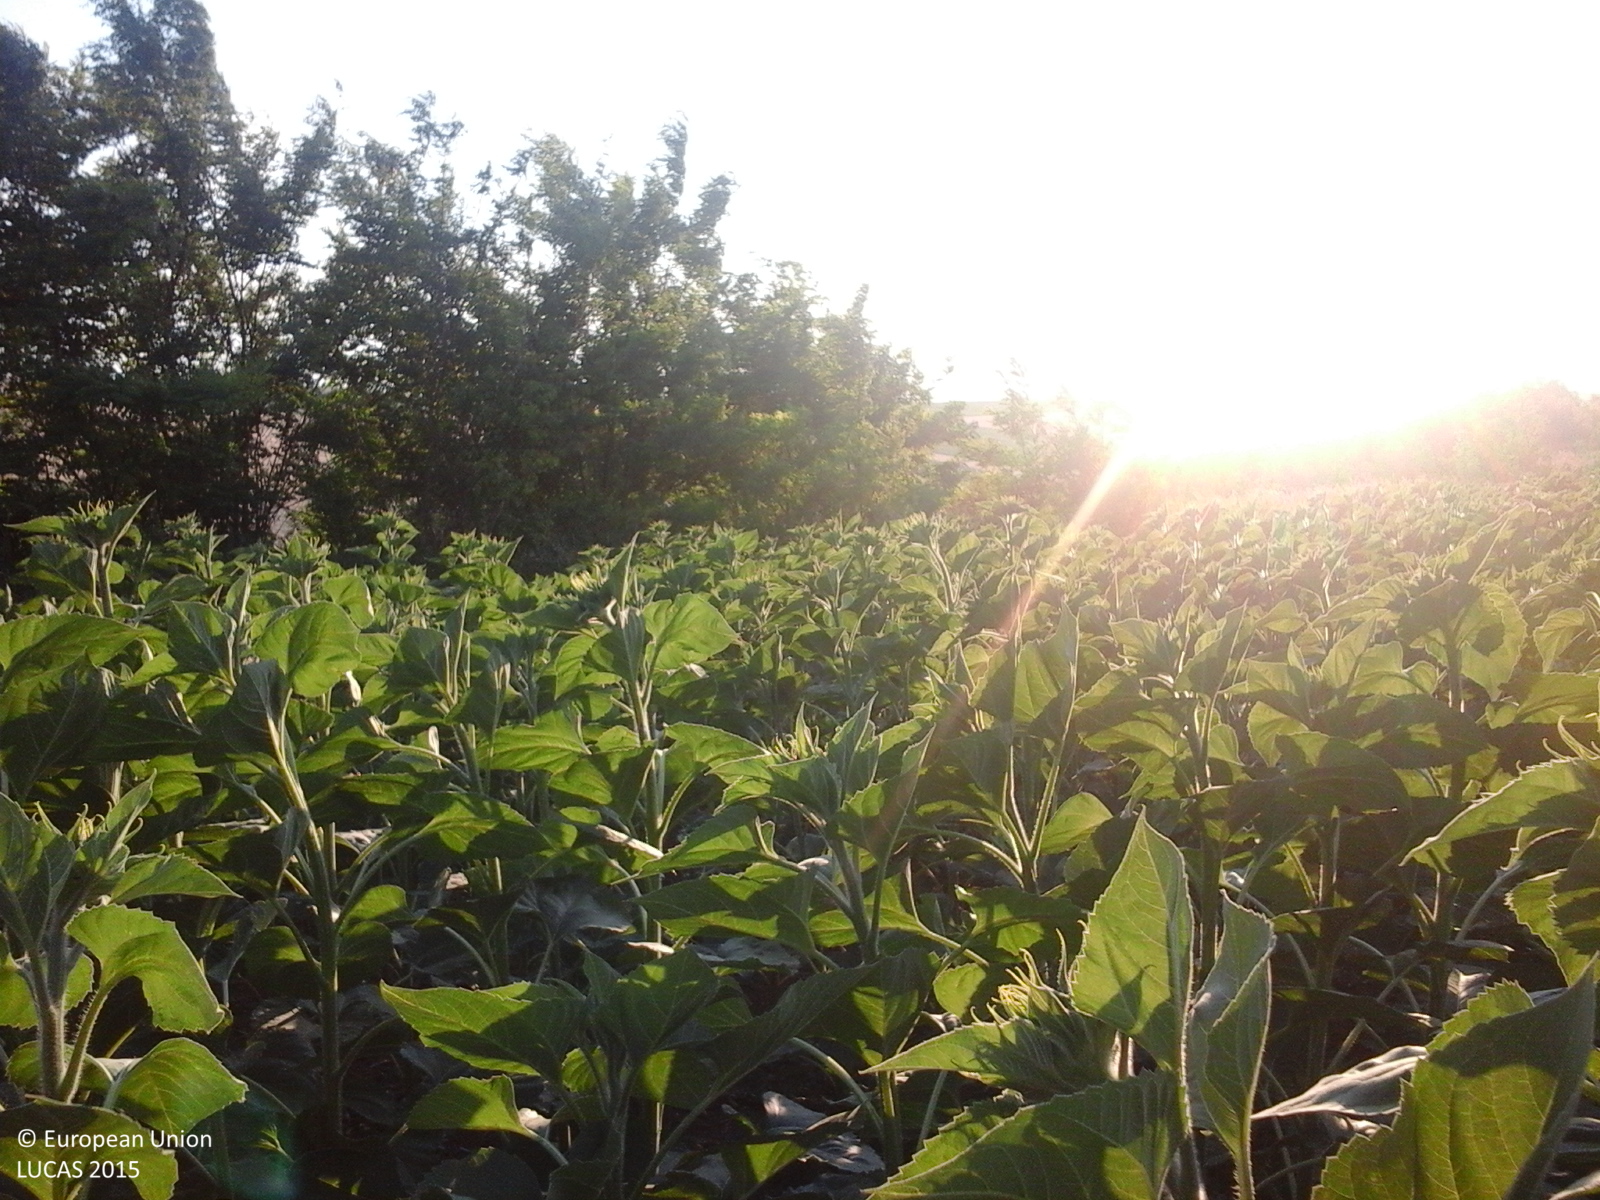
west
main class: Cropland
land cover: Sunflower
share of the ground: > 75 %
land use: Agriculture (excluding fallow land and kitchen gardens)
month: June
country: RO
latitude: 47.3952
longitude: 27.4044
